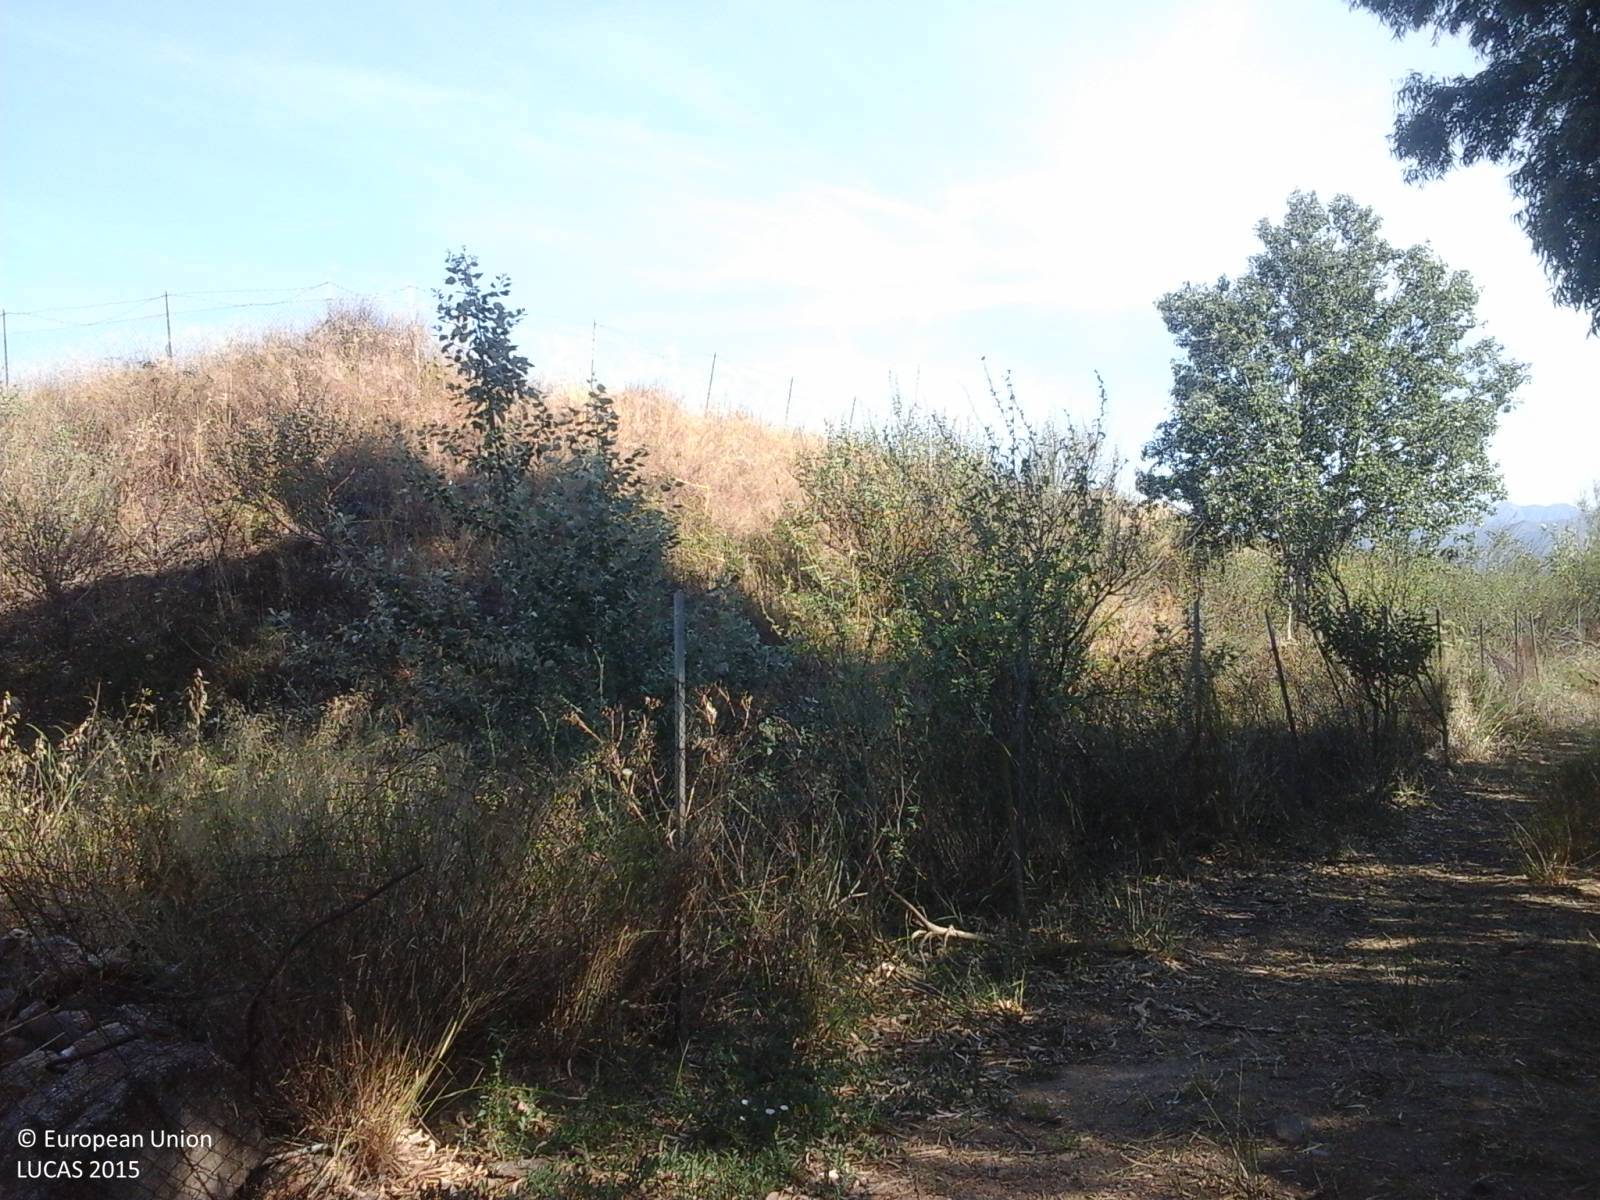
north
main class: Cropland
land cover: Temporary grasslands
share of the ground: > 75 %
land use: Agriculture (excluding fallow land and kitchen gardens)
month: June
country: IT
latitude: 39.2980
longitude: 8.6516
